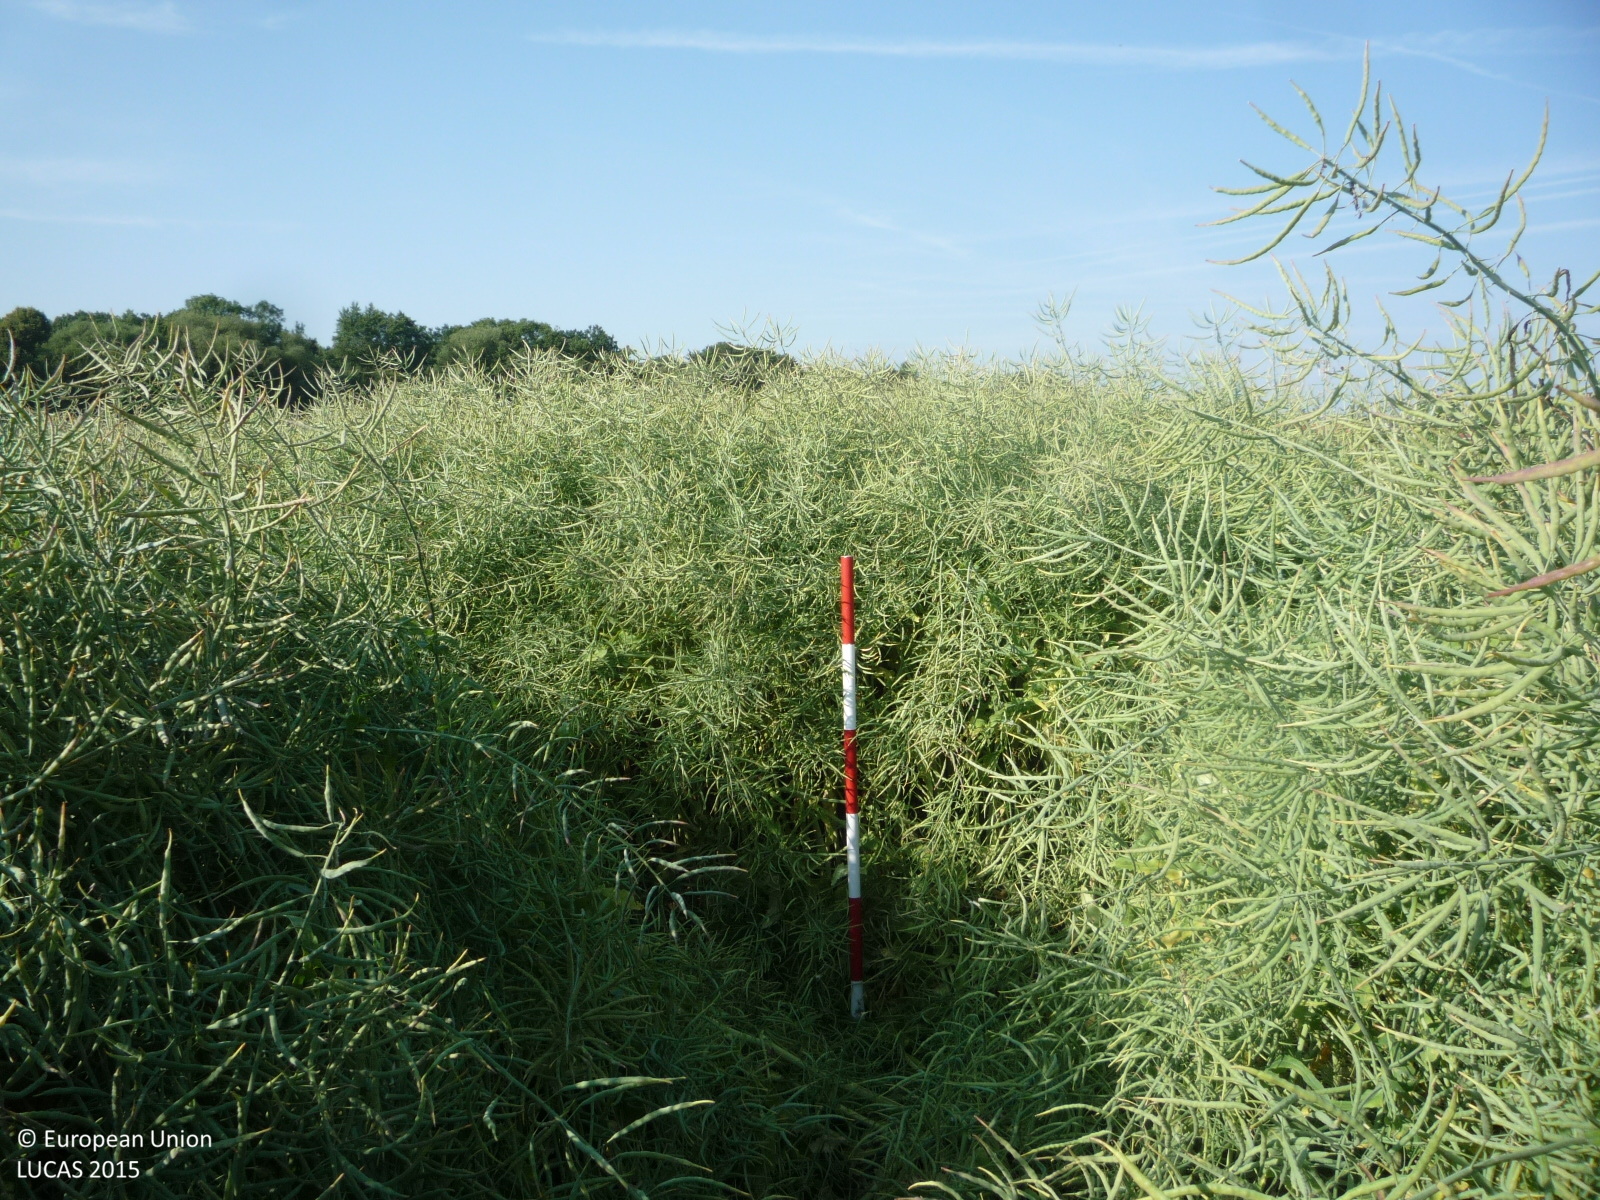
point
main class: Cropland
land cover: Rape and turnip rape
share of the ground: > 75 %
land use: Agriculture (excluding fallow land and kitchen gardens)
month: June
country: CZ
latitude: 49.9527
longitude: 15.6770
